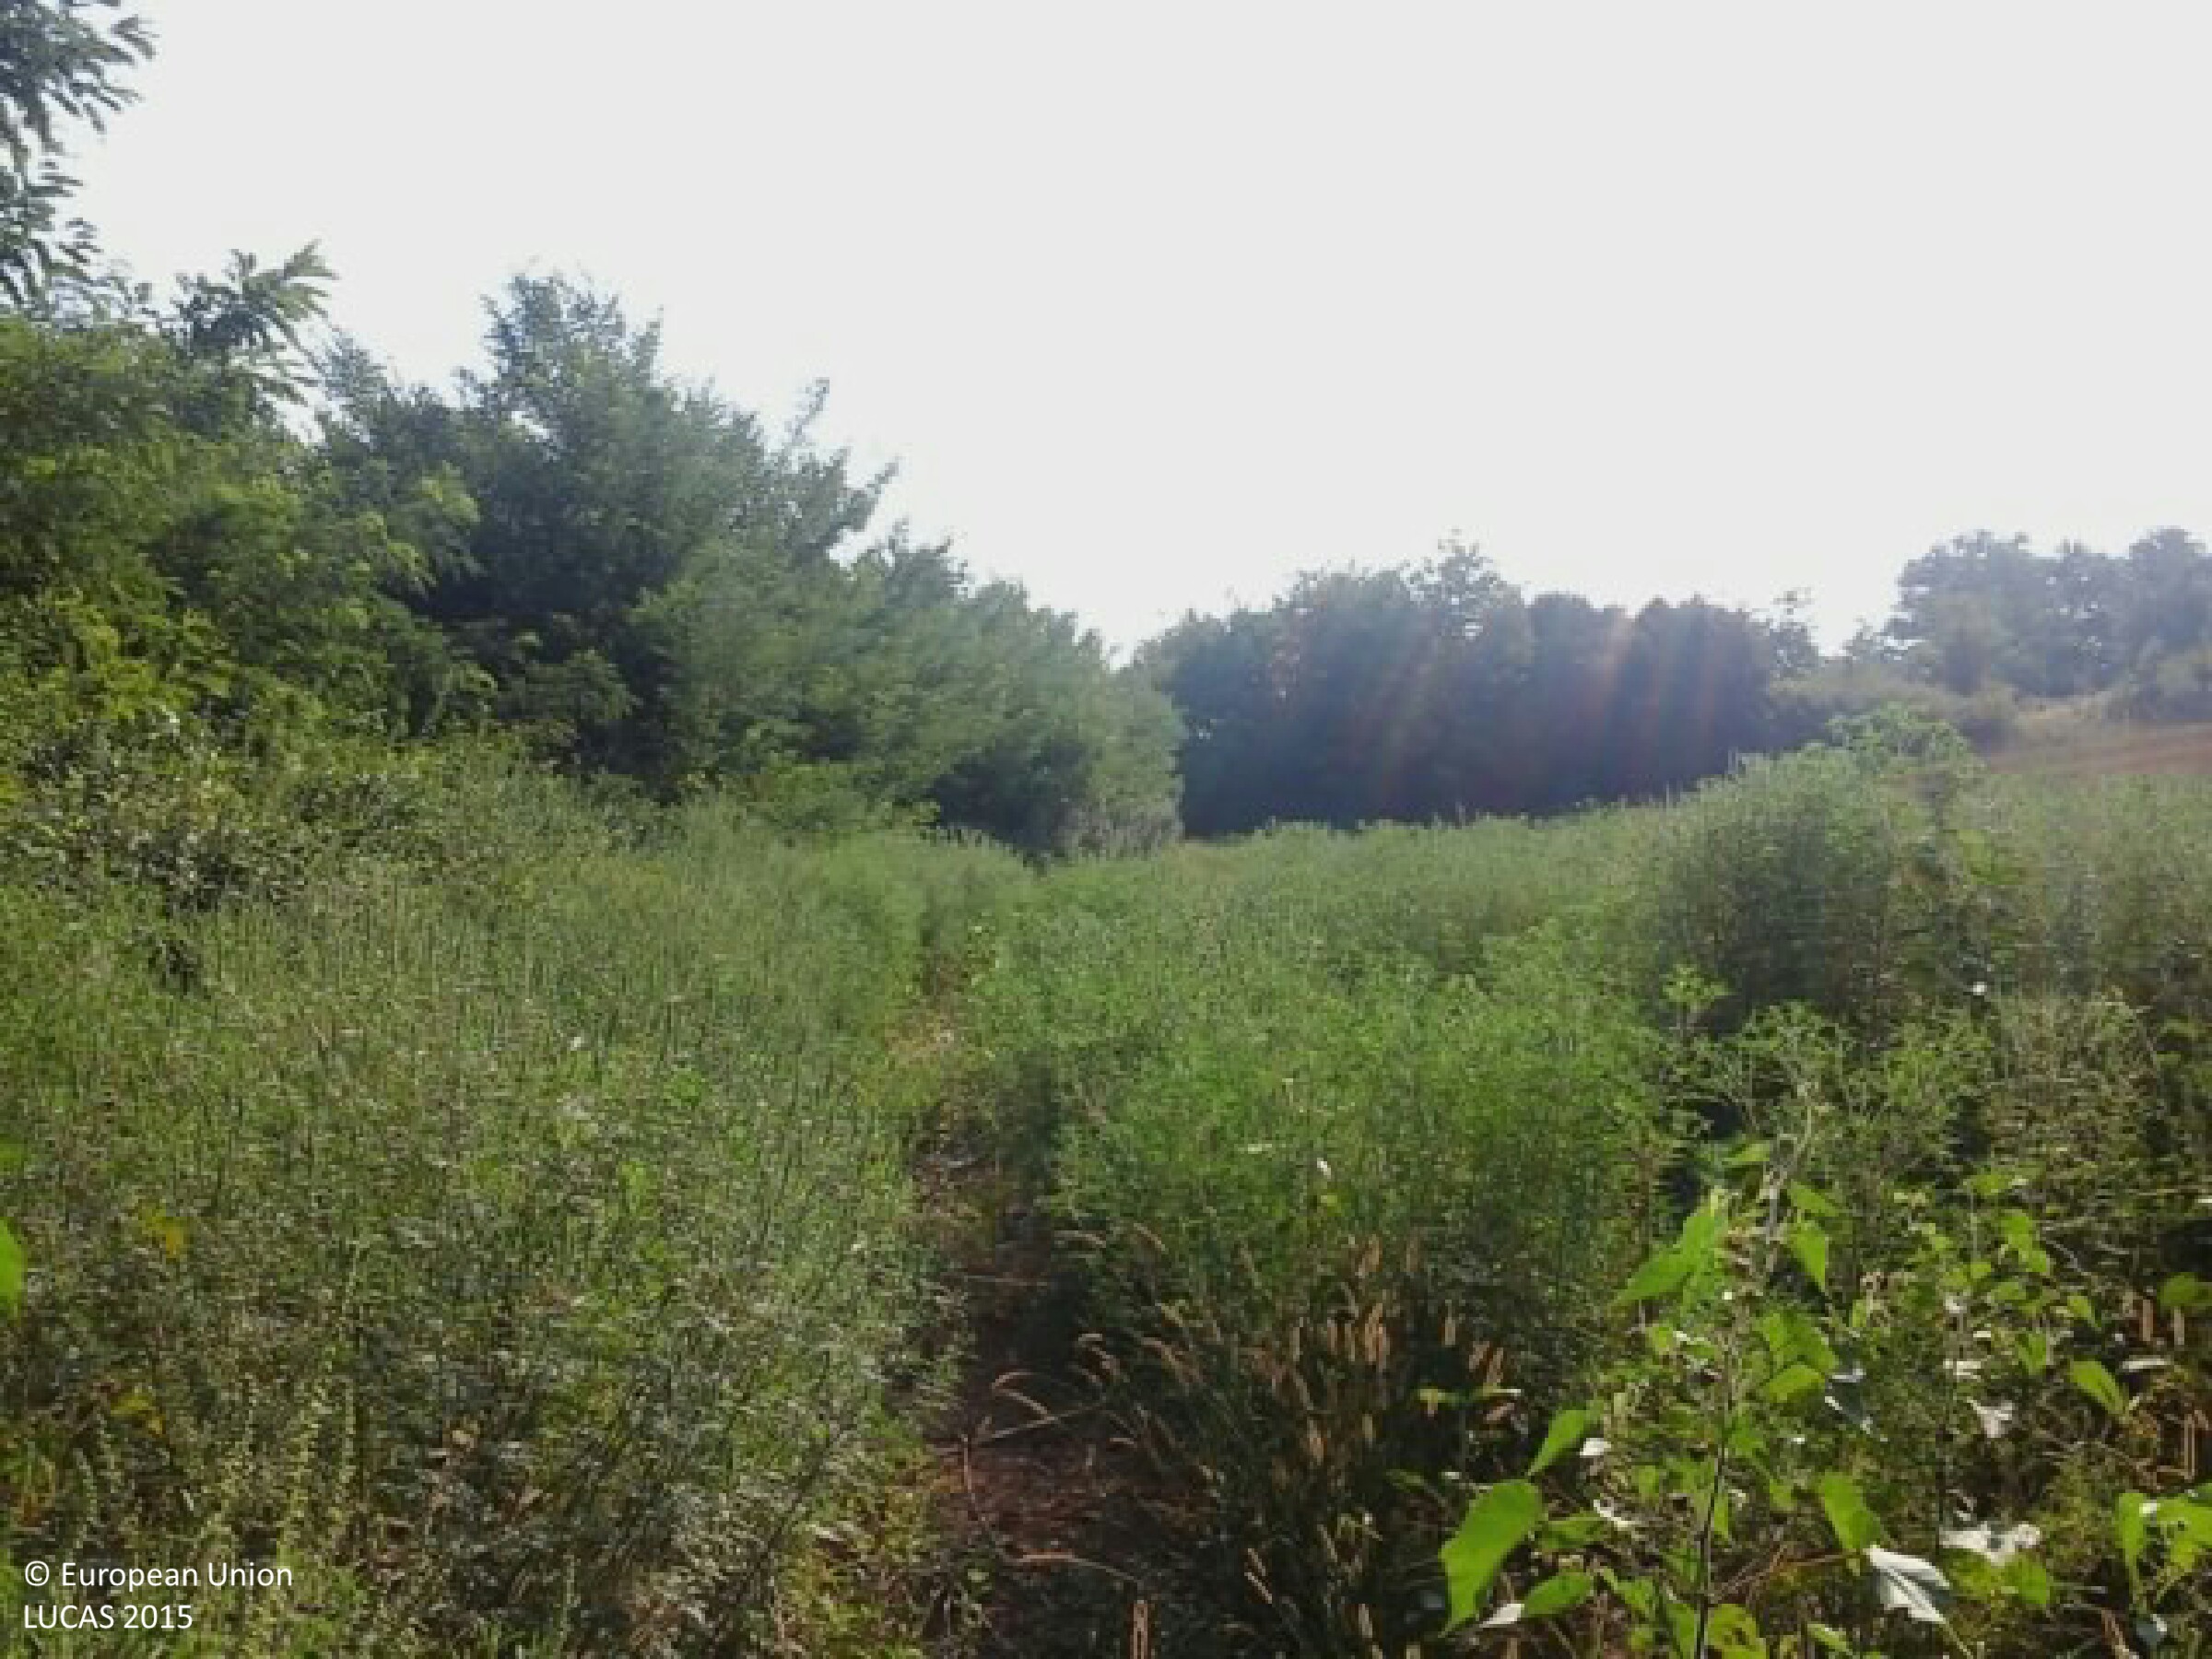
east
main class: Woodland
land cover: Broadleaved woodland
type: exotic forest
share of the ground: > 75 %
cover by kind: shrubs 60 %, broadleaved forest trees 40 %
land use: Abandoned areas
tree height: < 5 m
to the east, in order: Broadleaved woodland; Inland marshes
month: August
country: HU
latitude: 46.2954
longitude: 18.3559
